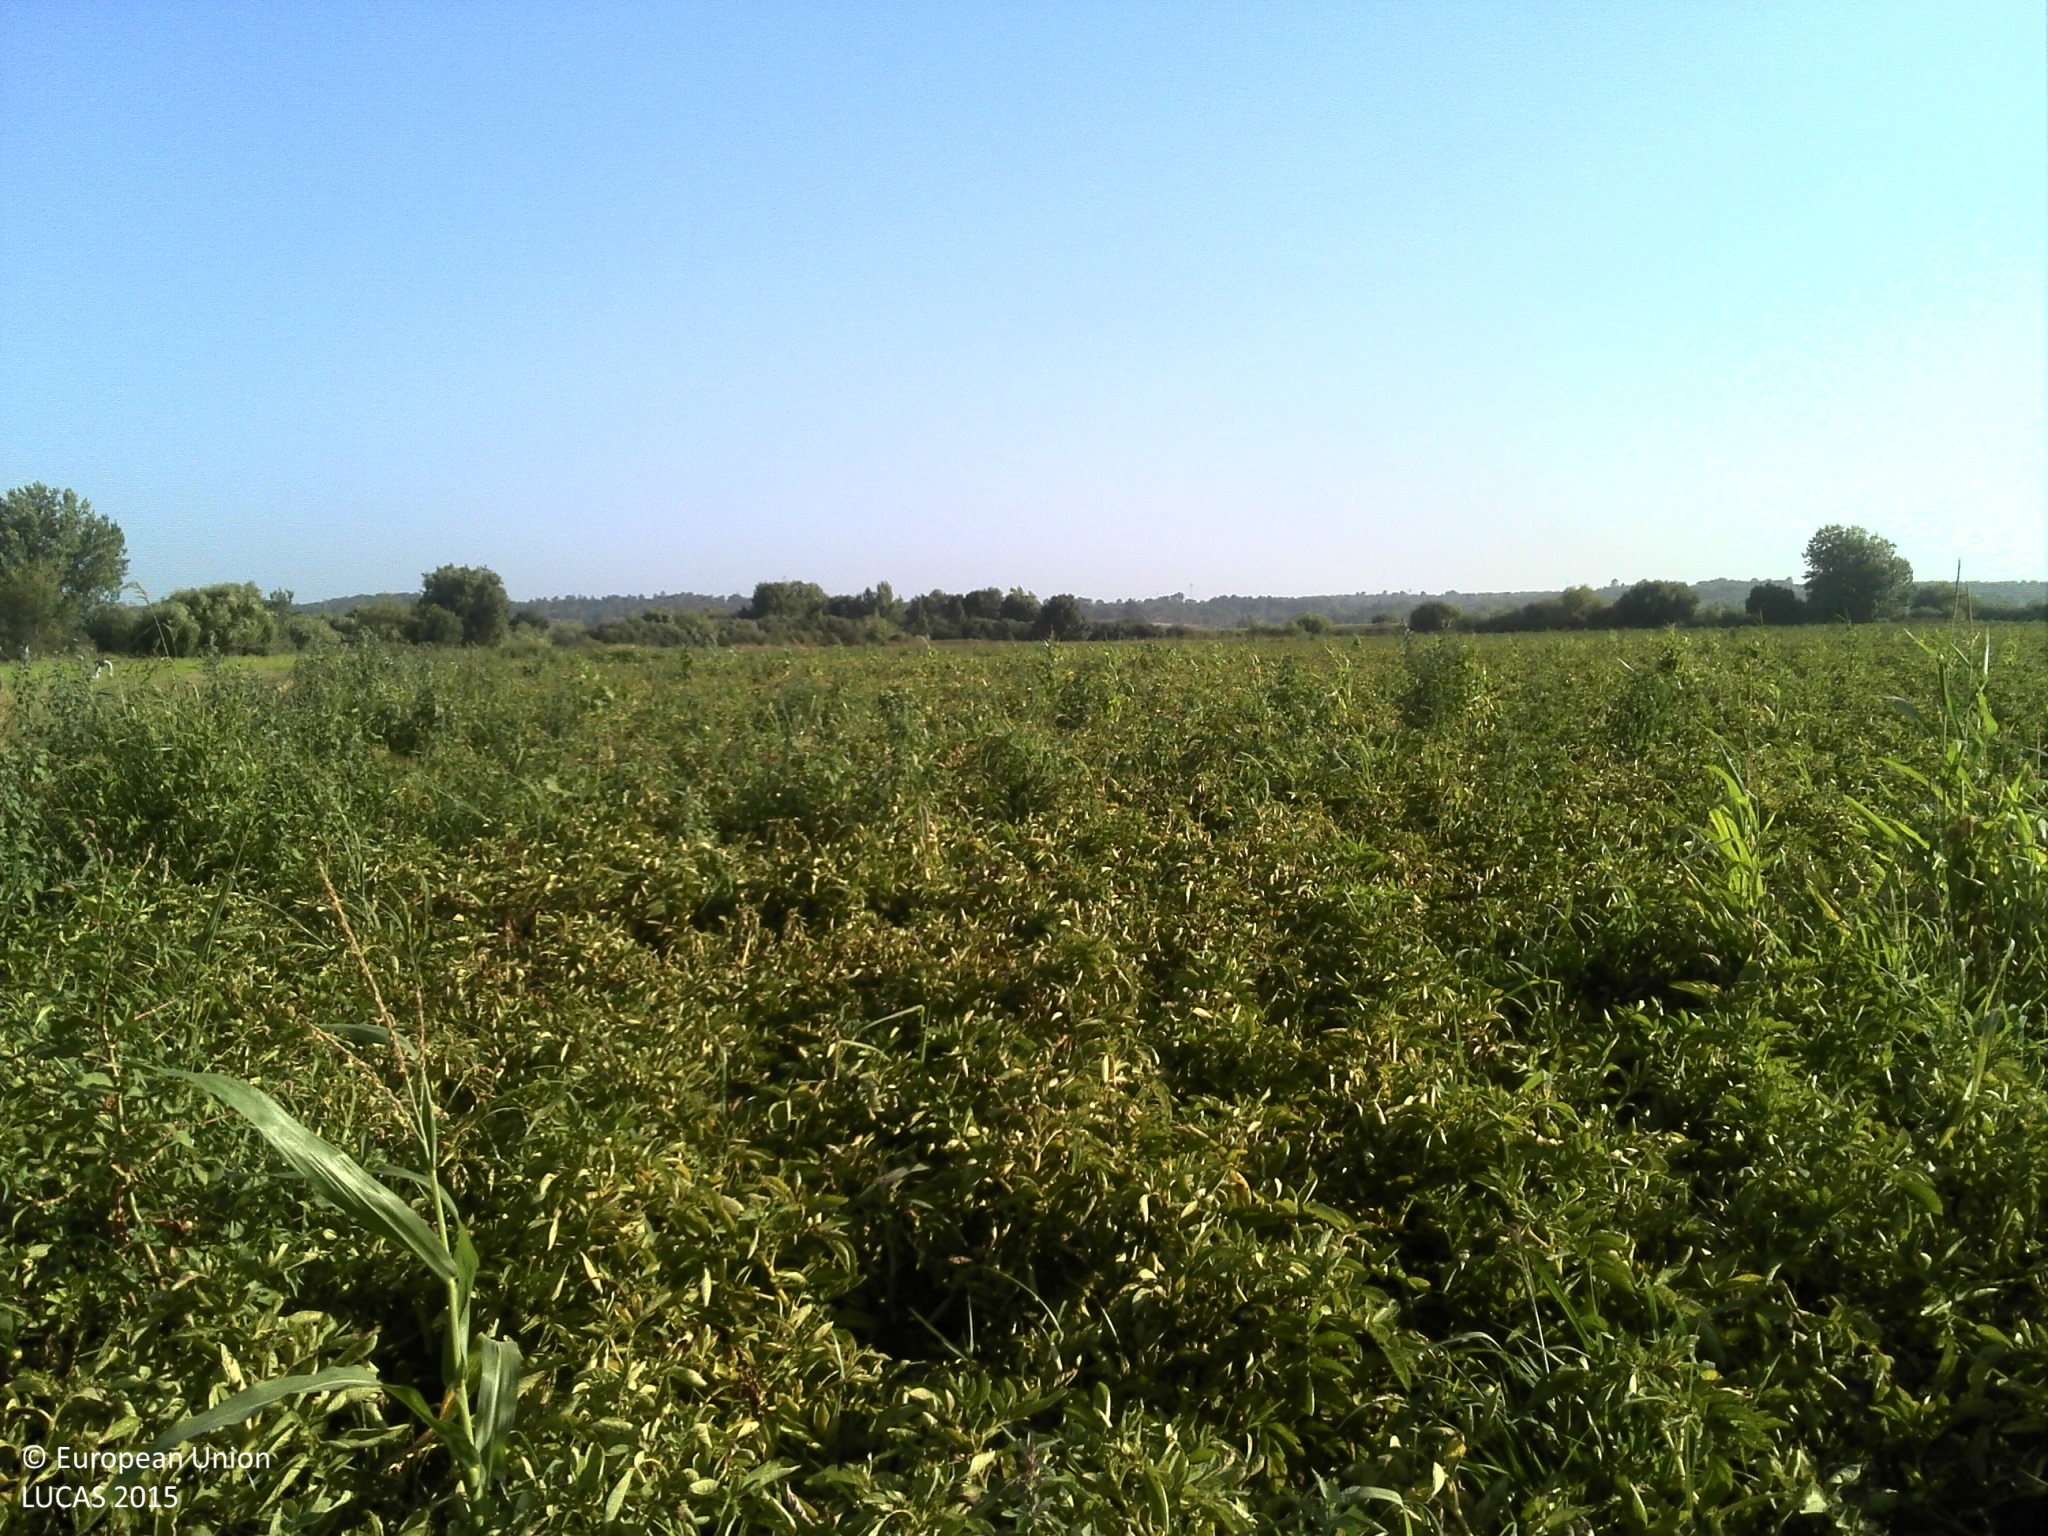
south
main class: Cropland
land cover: Potatoes
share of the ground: > 75 %
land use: Agriculture (excluding fallow land and kitchen gardens)
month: July
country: PT
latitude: 38.9376
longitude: -8.5800
